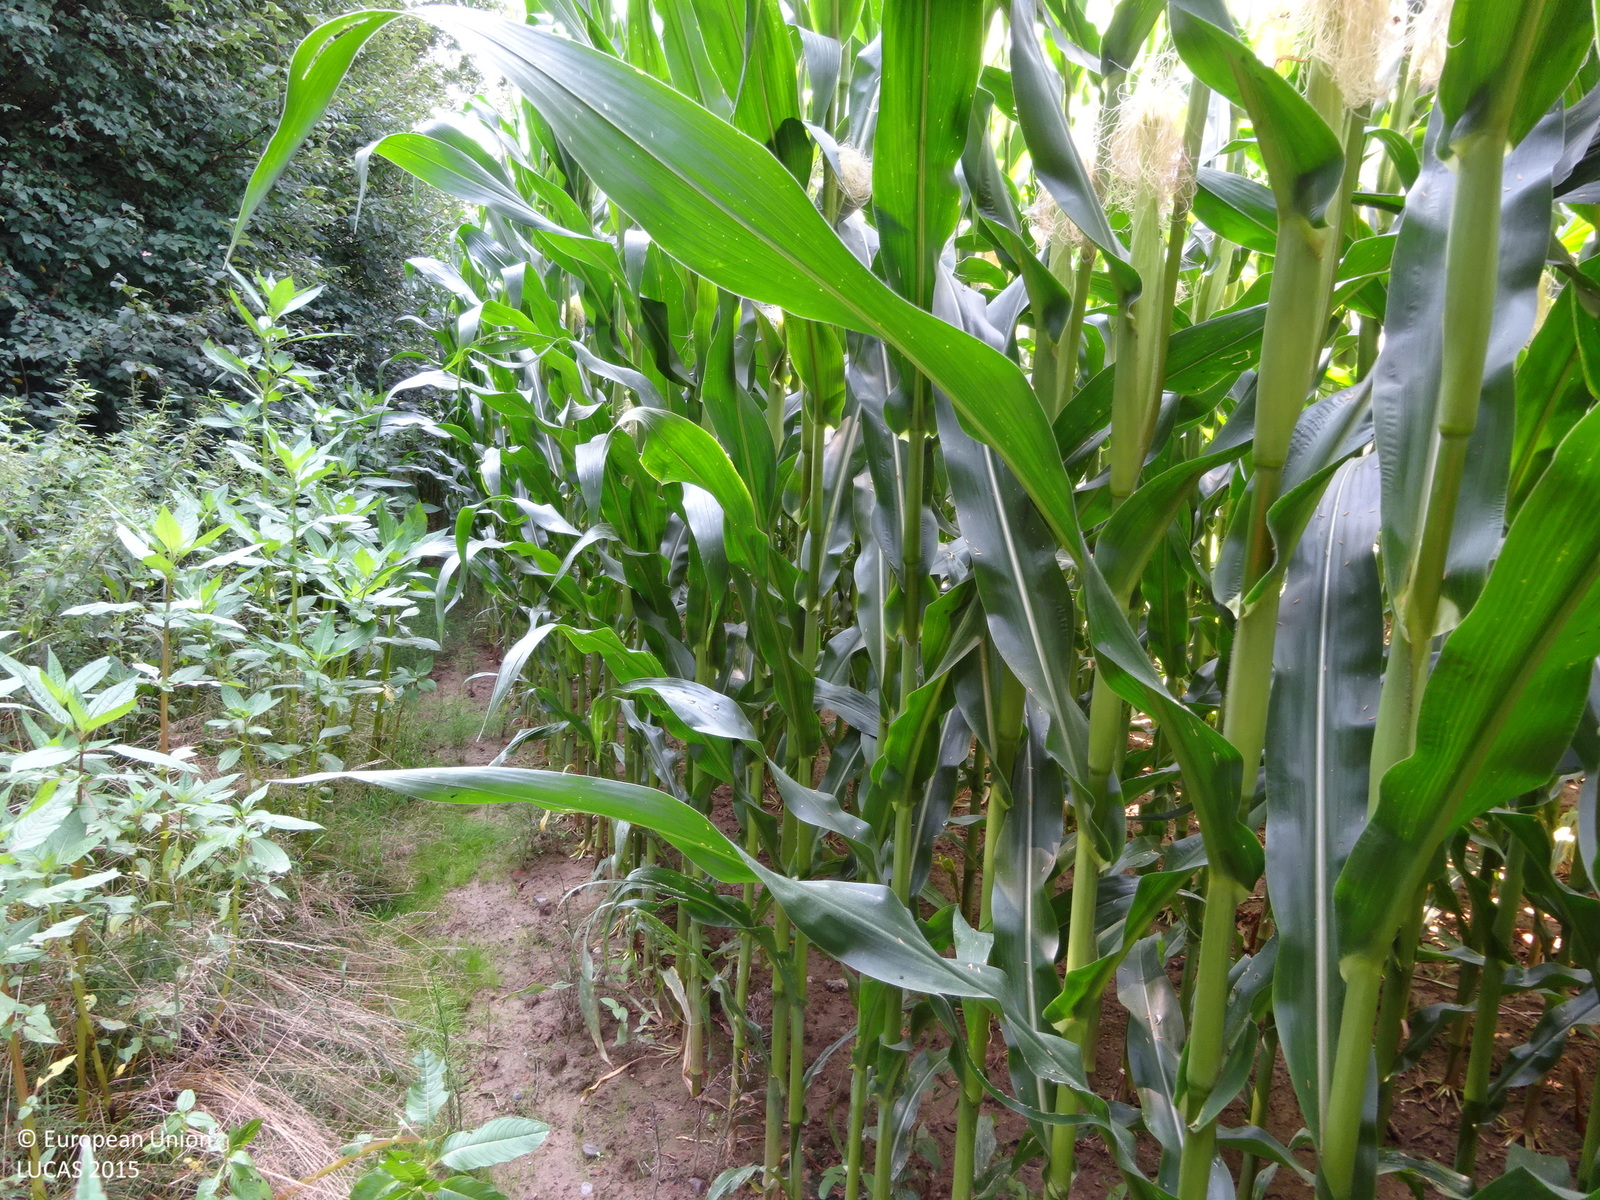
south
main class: Cropland
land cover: Maize
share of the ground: > 75 %
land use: Agriculture (excluding fallow land and kitchen gardens)
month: July
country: AT
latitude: 46.8624
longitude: 15.4432
